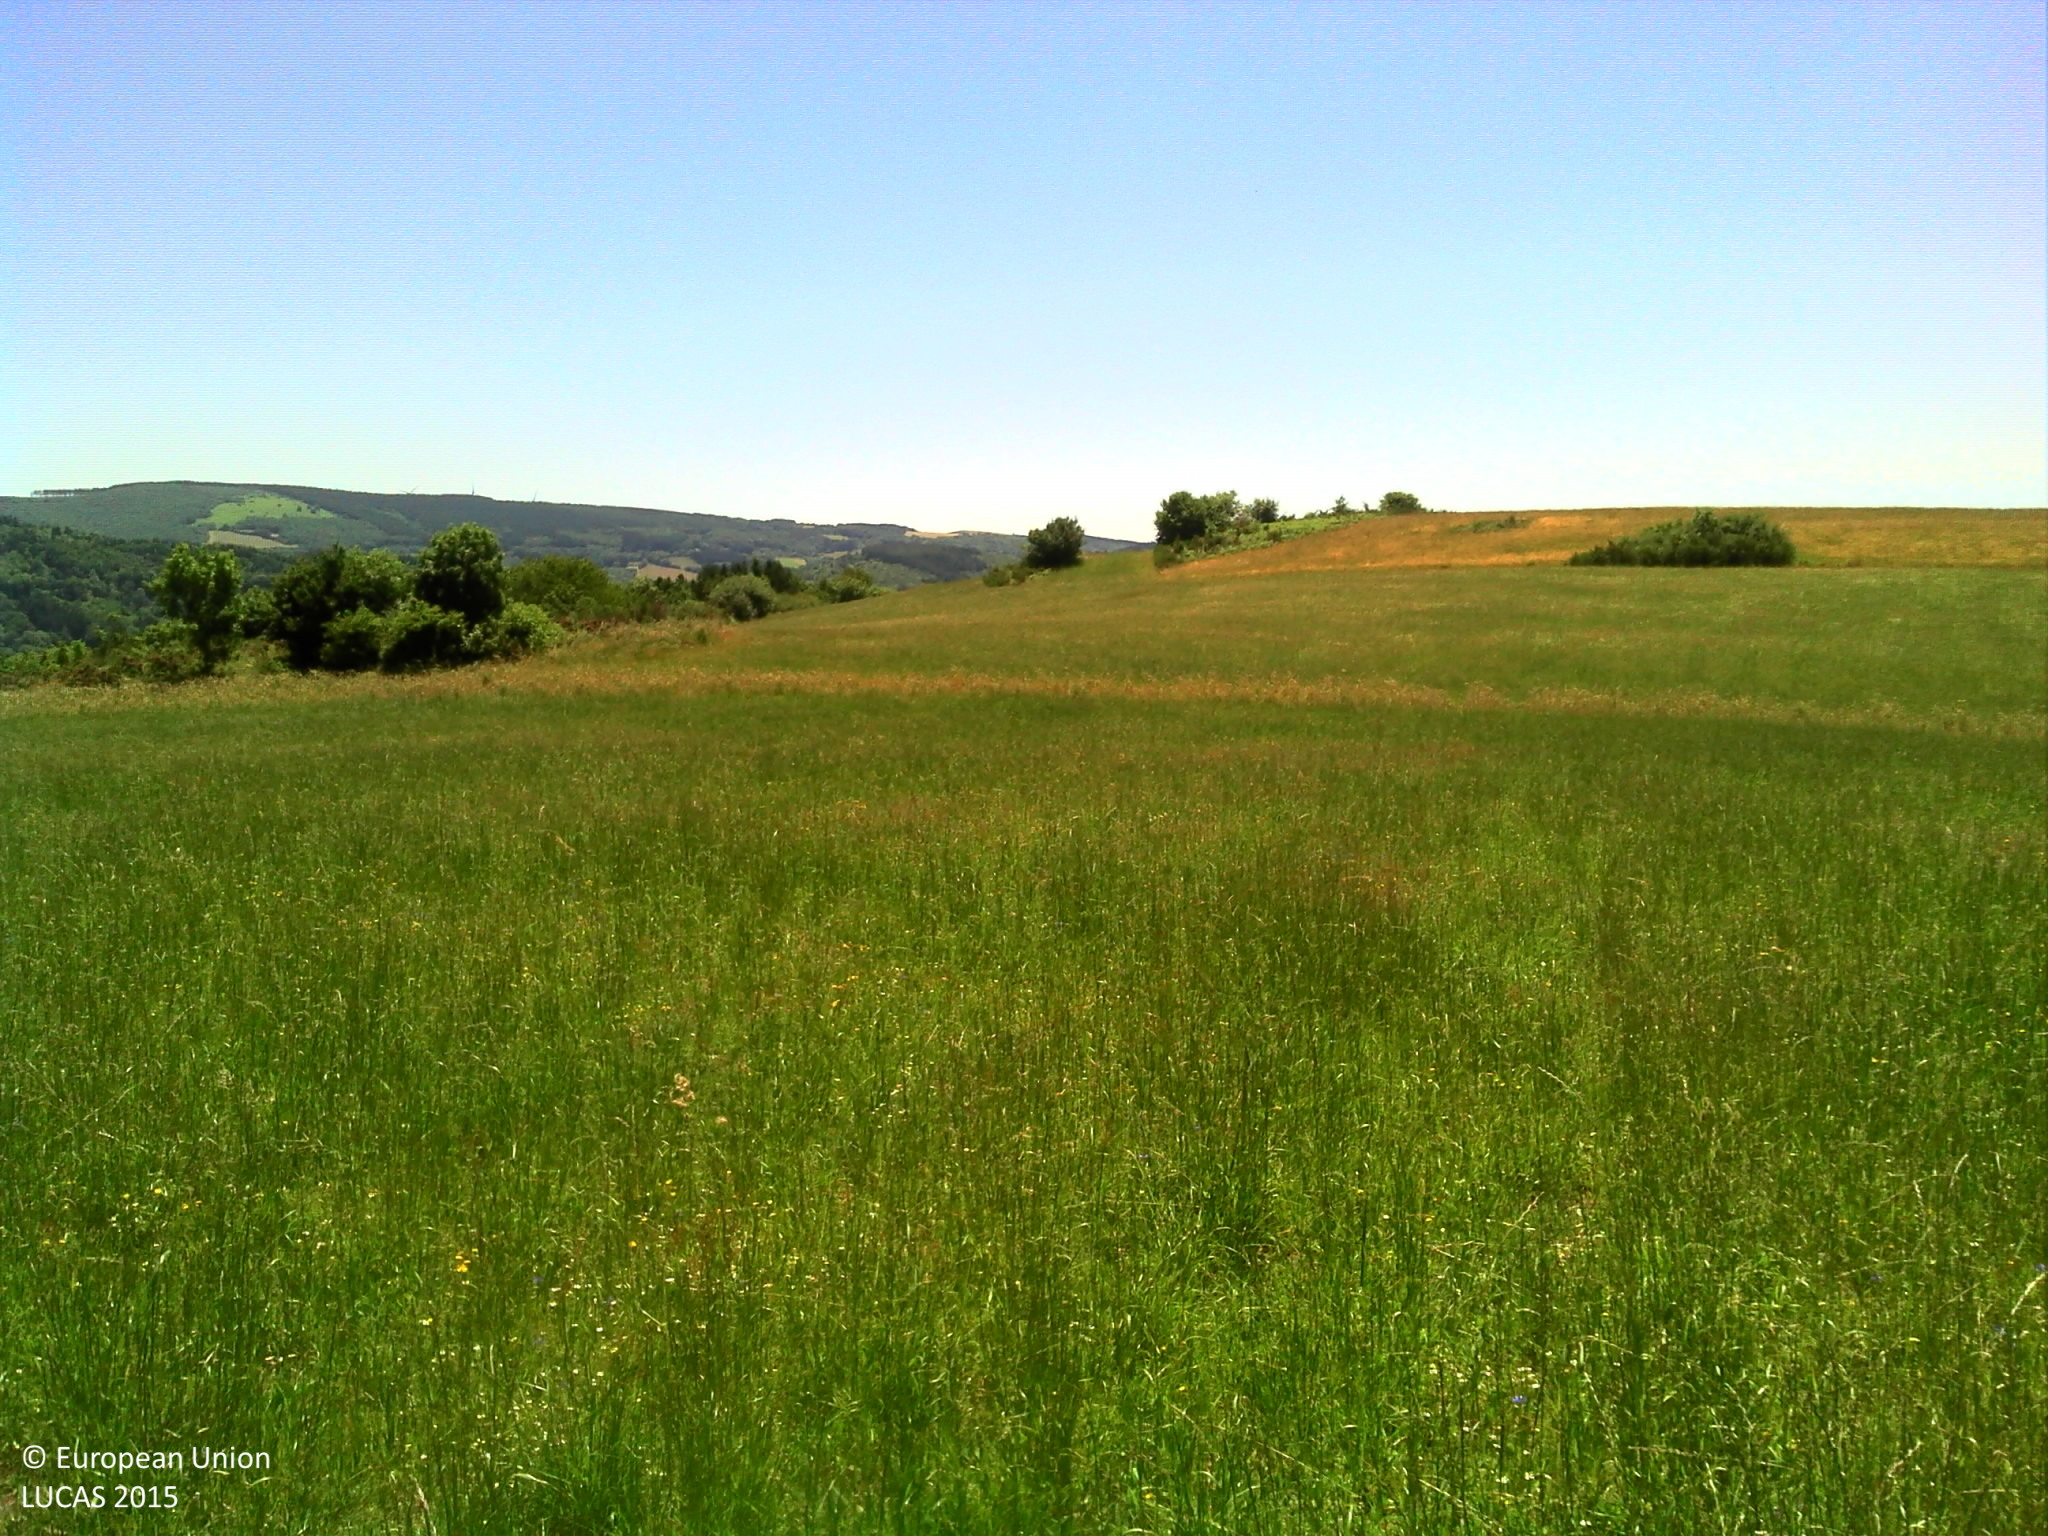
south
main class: Grassland
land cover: Grassland without tree/shrub cover
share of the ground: > 75 %
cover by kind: herbaceous plants 100 %
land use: Agriculture (excluding fallow land and kitchen gardens)
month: June
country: FR
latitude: 43.7219
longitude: 2.5708
